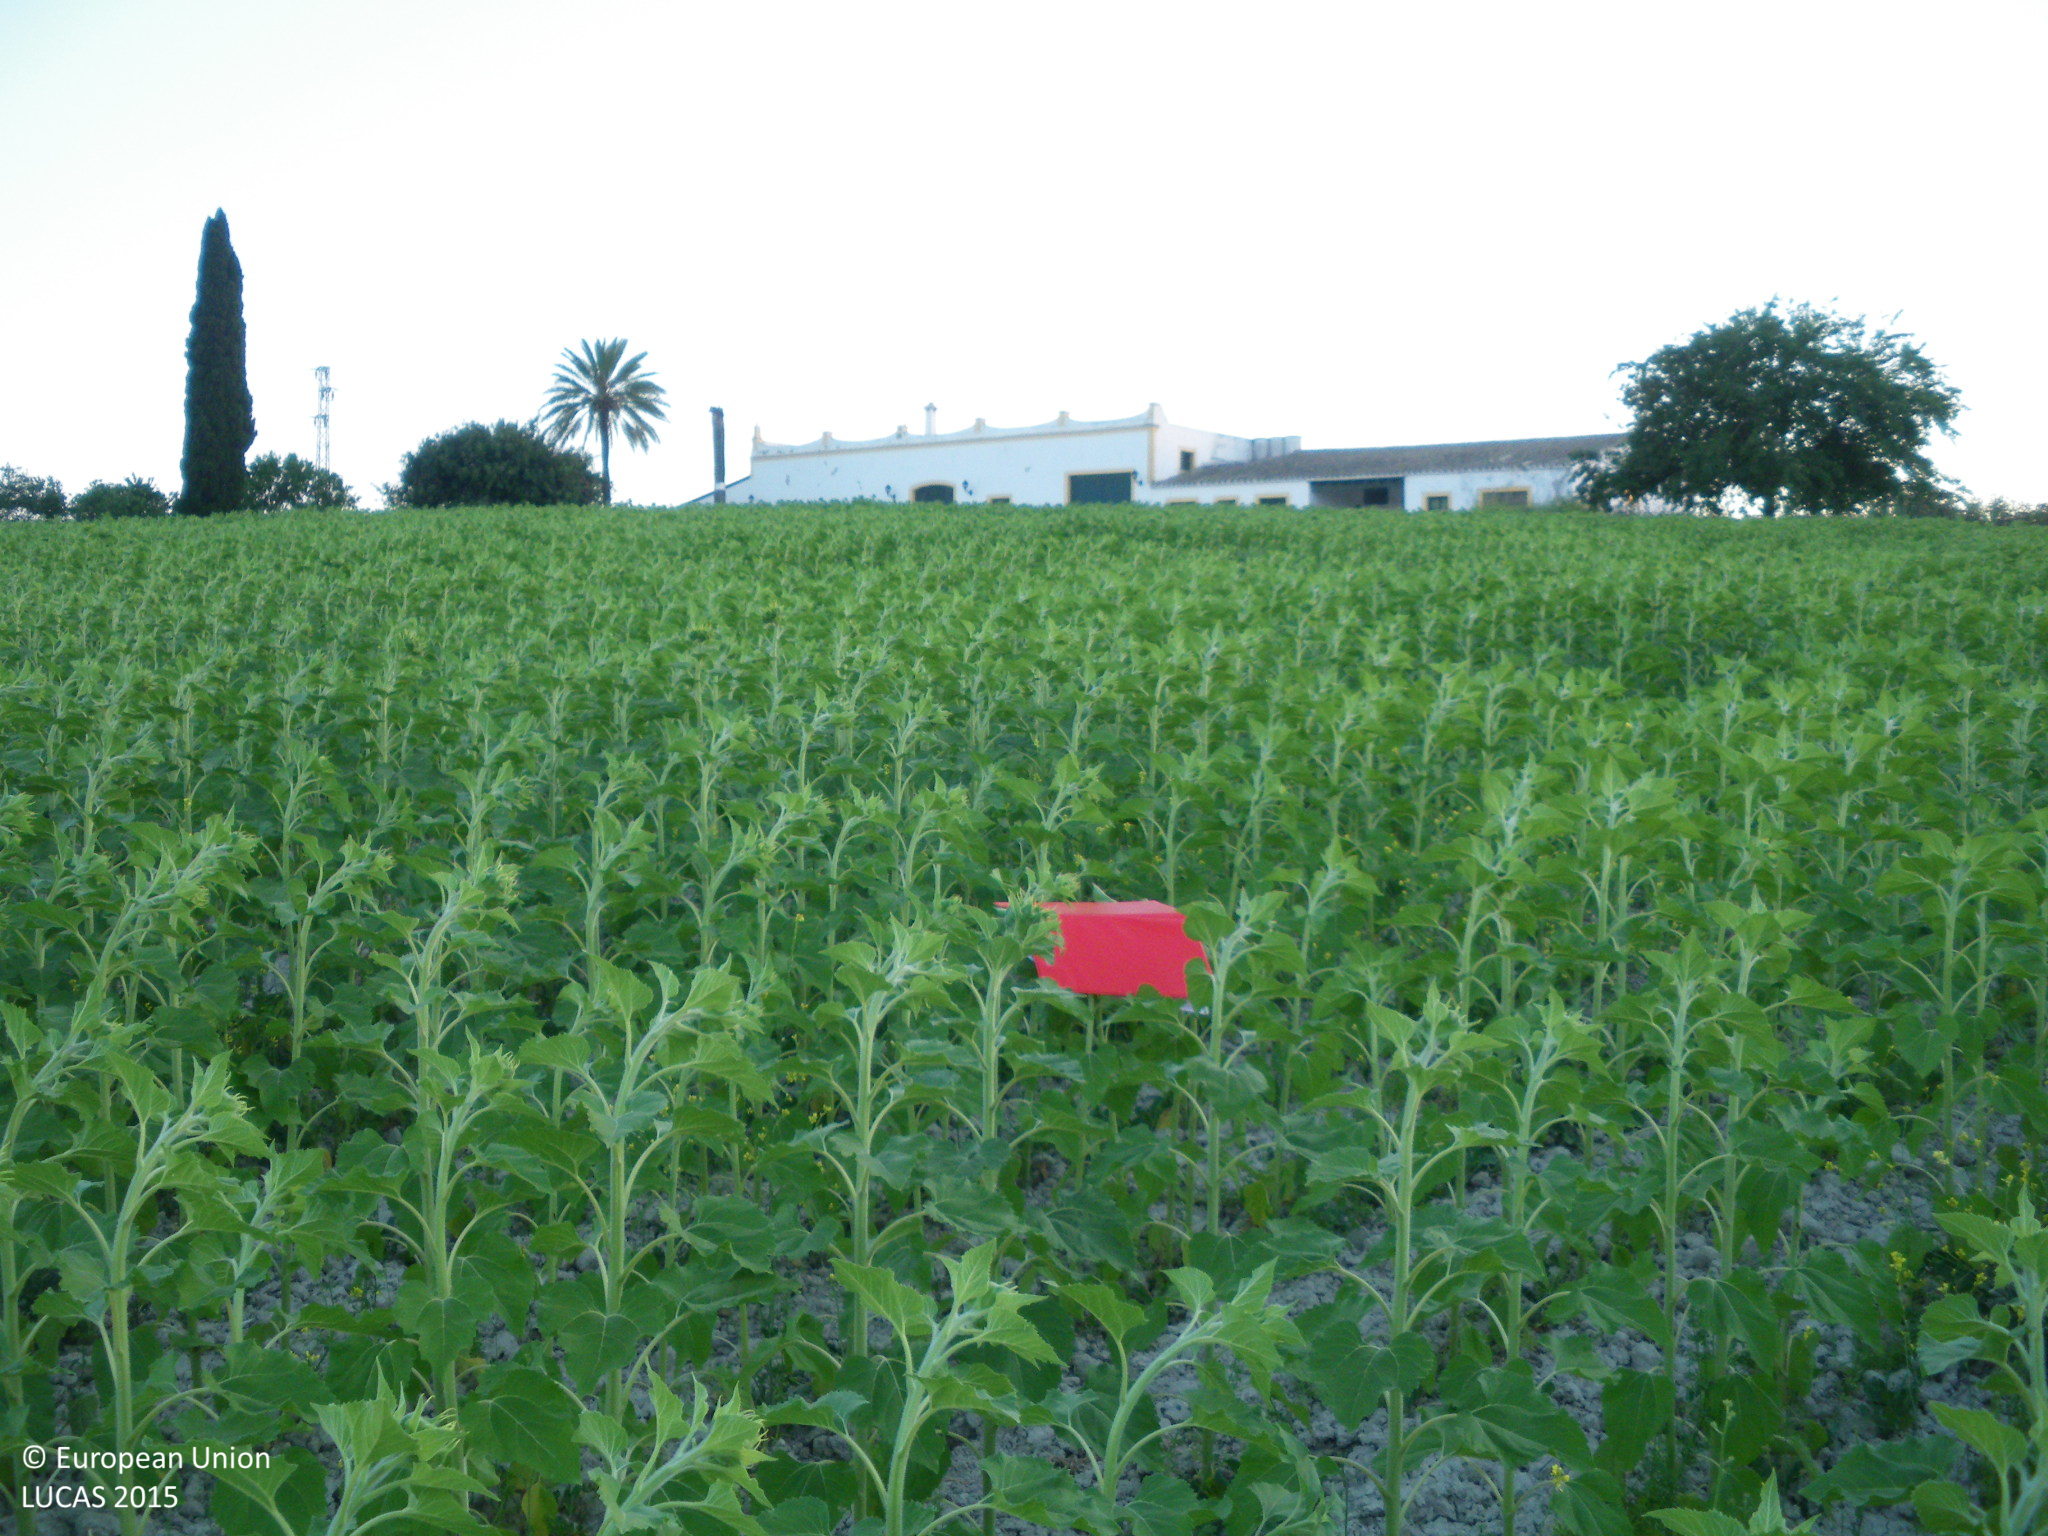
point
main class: Cropland
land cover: Sunflower
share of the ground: 50 - 75 %
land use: Agriculture (excluding fallow land and kitchen gardens)
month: May
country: ES
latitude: 36.7151
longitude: -6.2138
